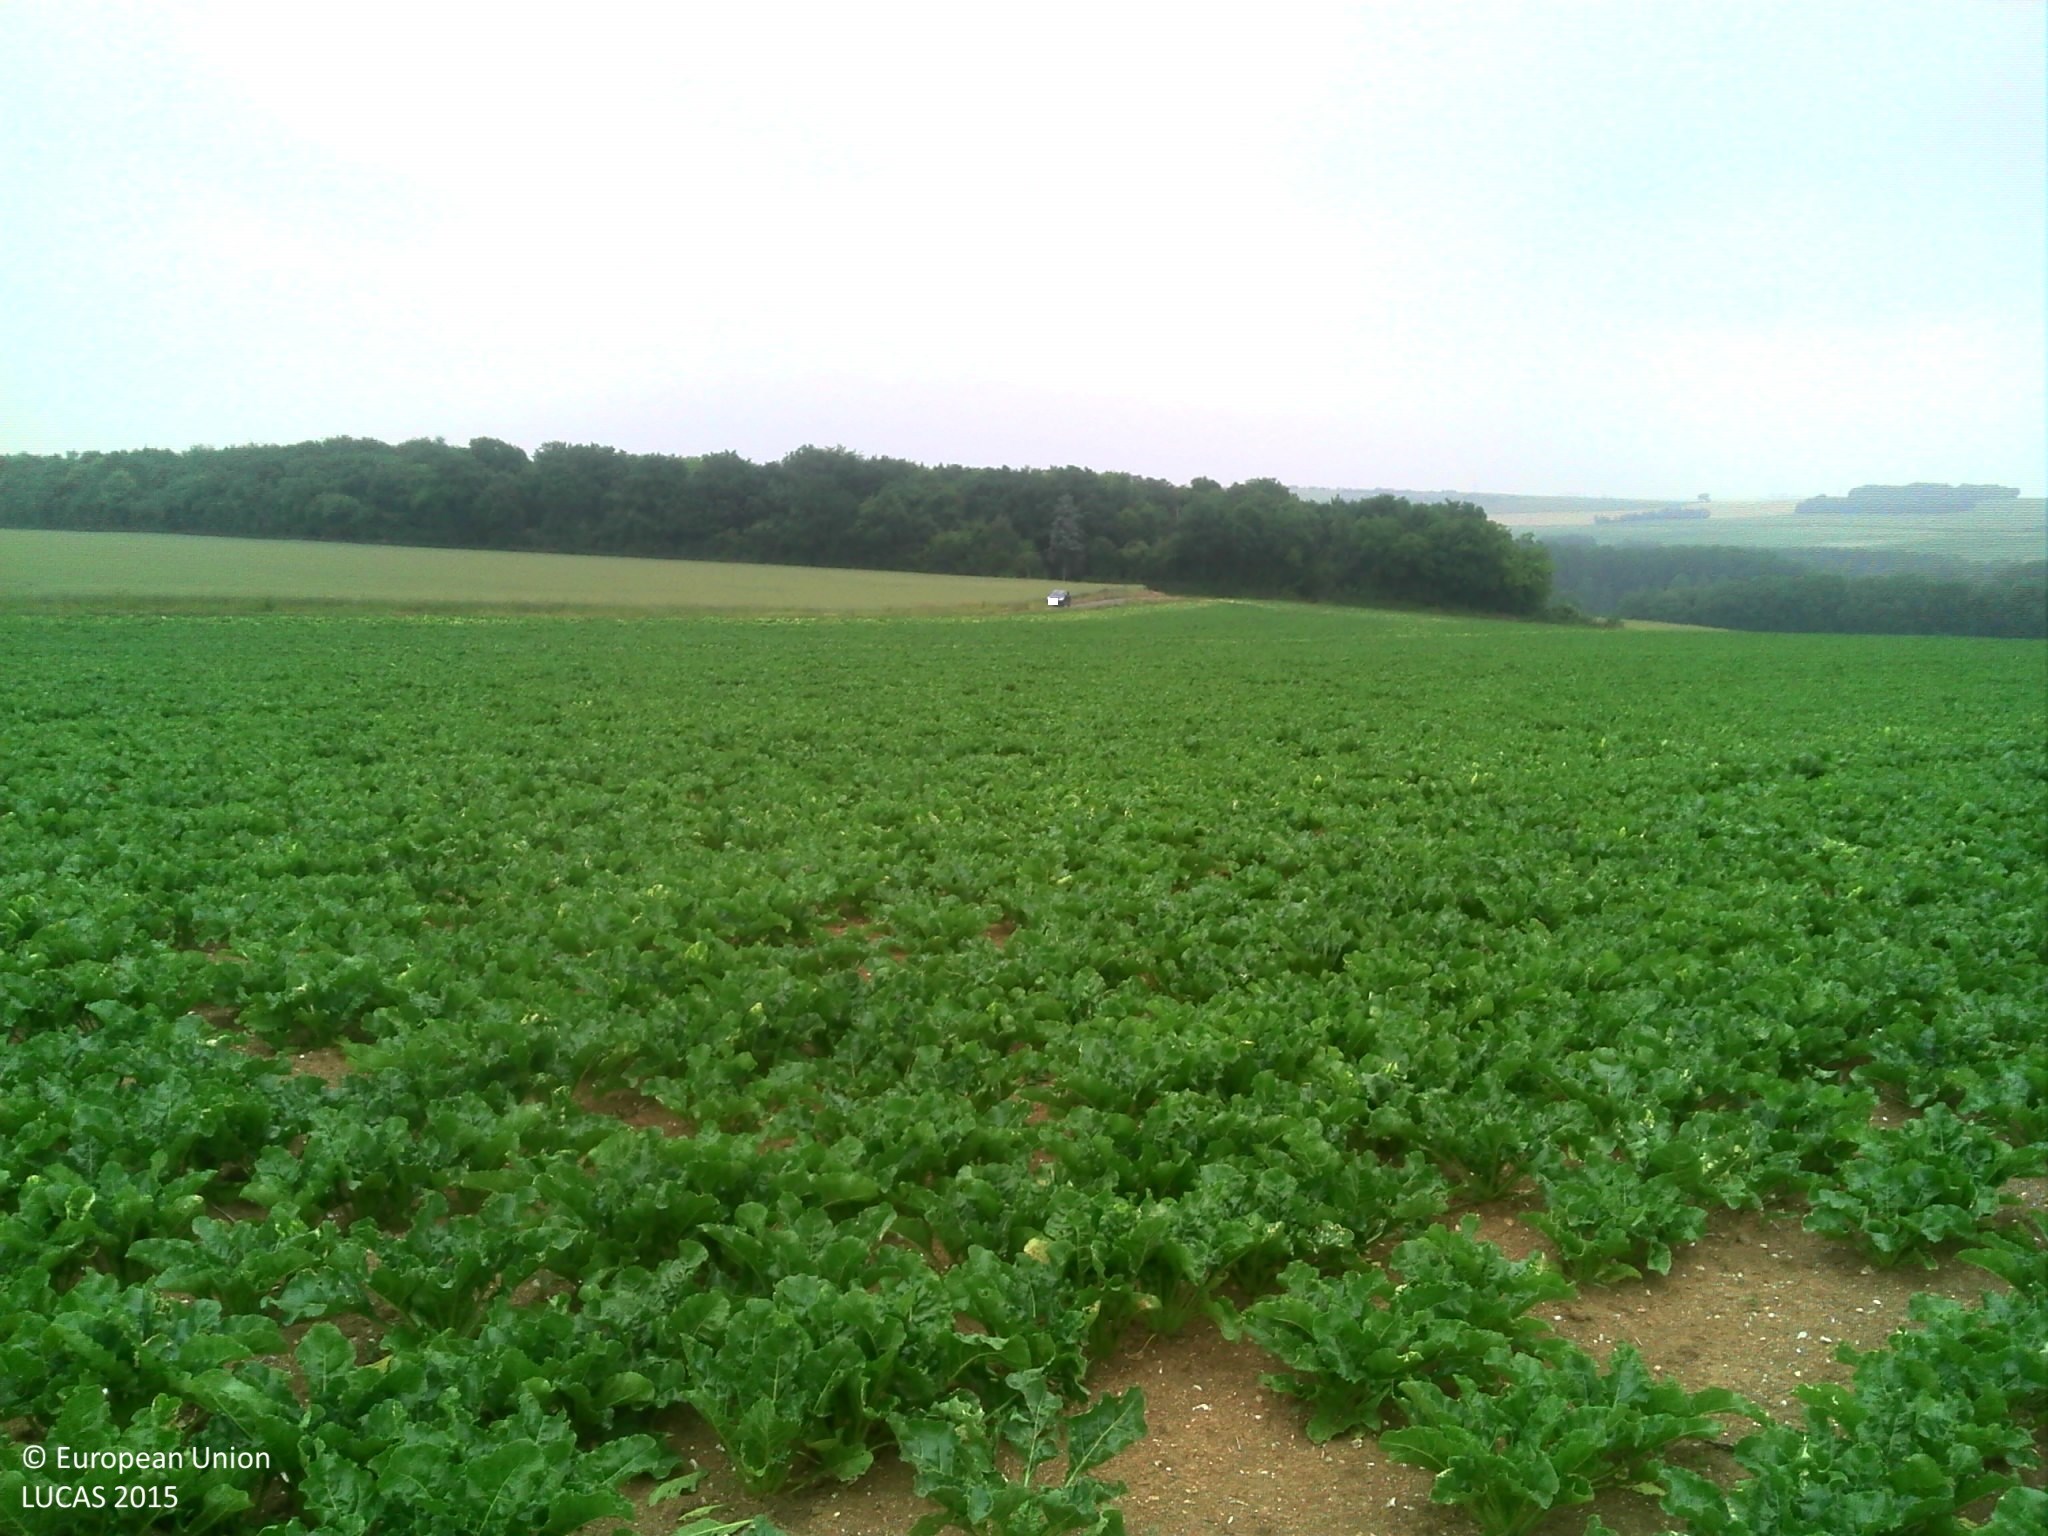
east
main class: Cropland
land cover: Sugar beet
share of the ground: > 75 %
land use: Agriculture (excluding fallow land and kitchen gardens)
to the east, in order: Sugar beet; Grass margins; Paved roads, cycling and walking lanes
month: June
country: FR
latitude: 49.8077
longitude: 2.1905
